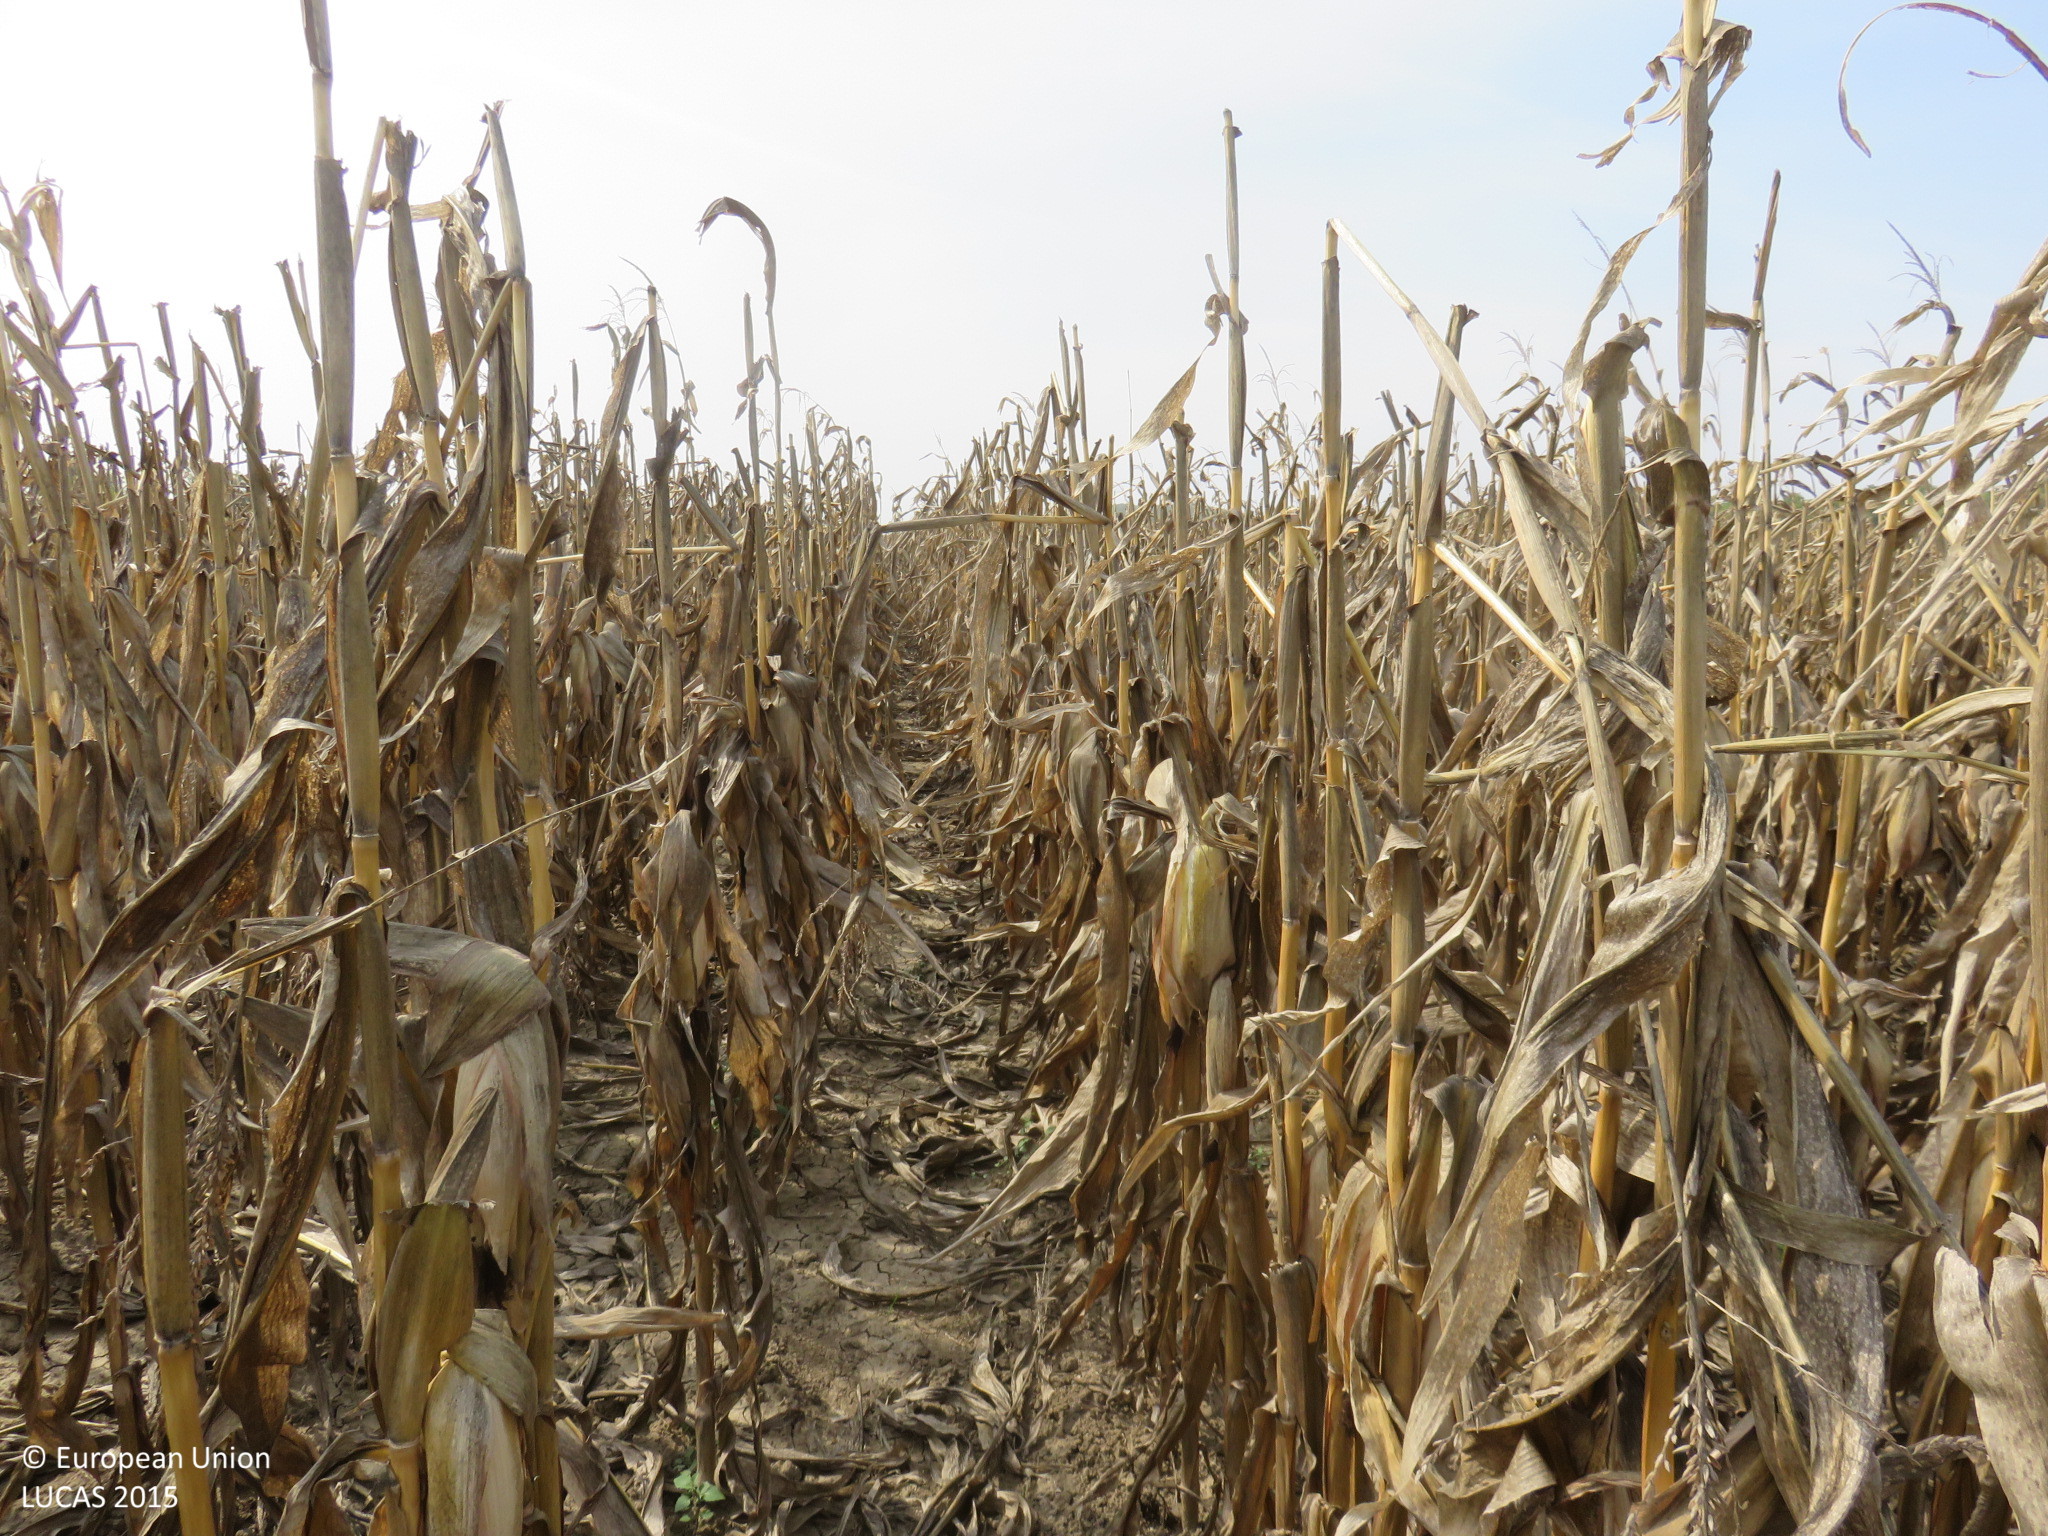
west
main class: Cropland
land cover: Maize
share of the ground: > 75 %
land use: Agriculture (excluding fallow land and kitchen gardens)
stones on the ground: < 10 %
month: September
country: BG
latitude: 43.4740
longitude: 24.9919
